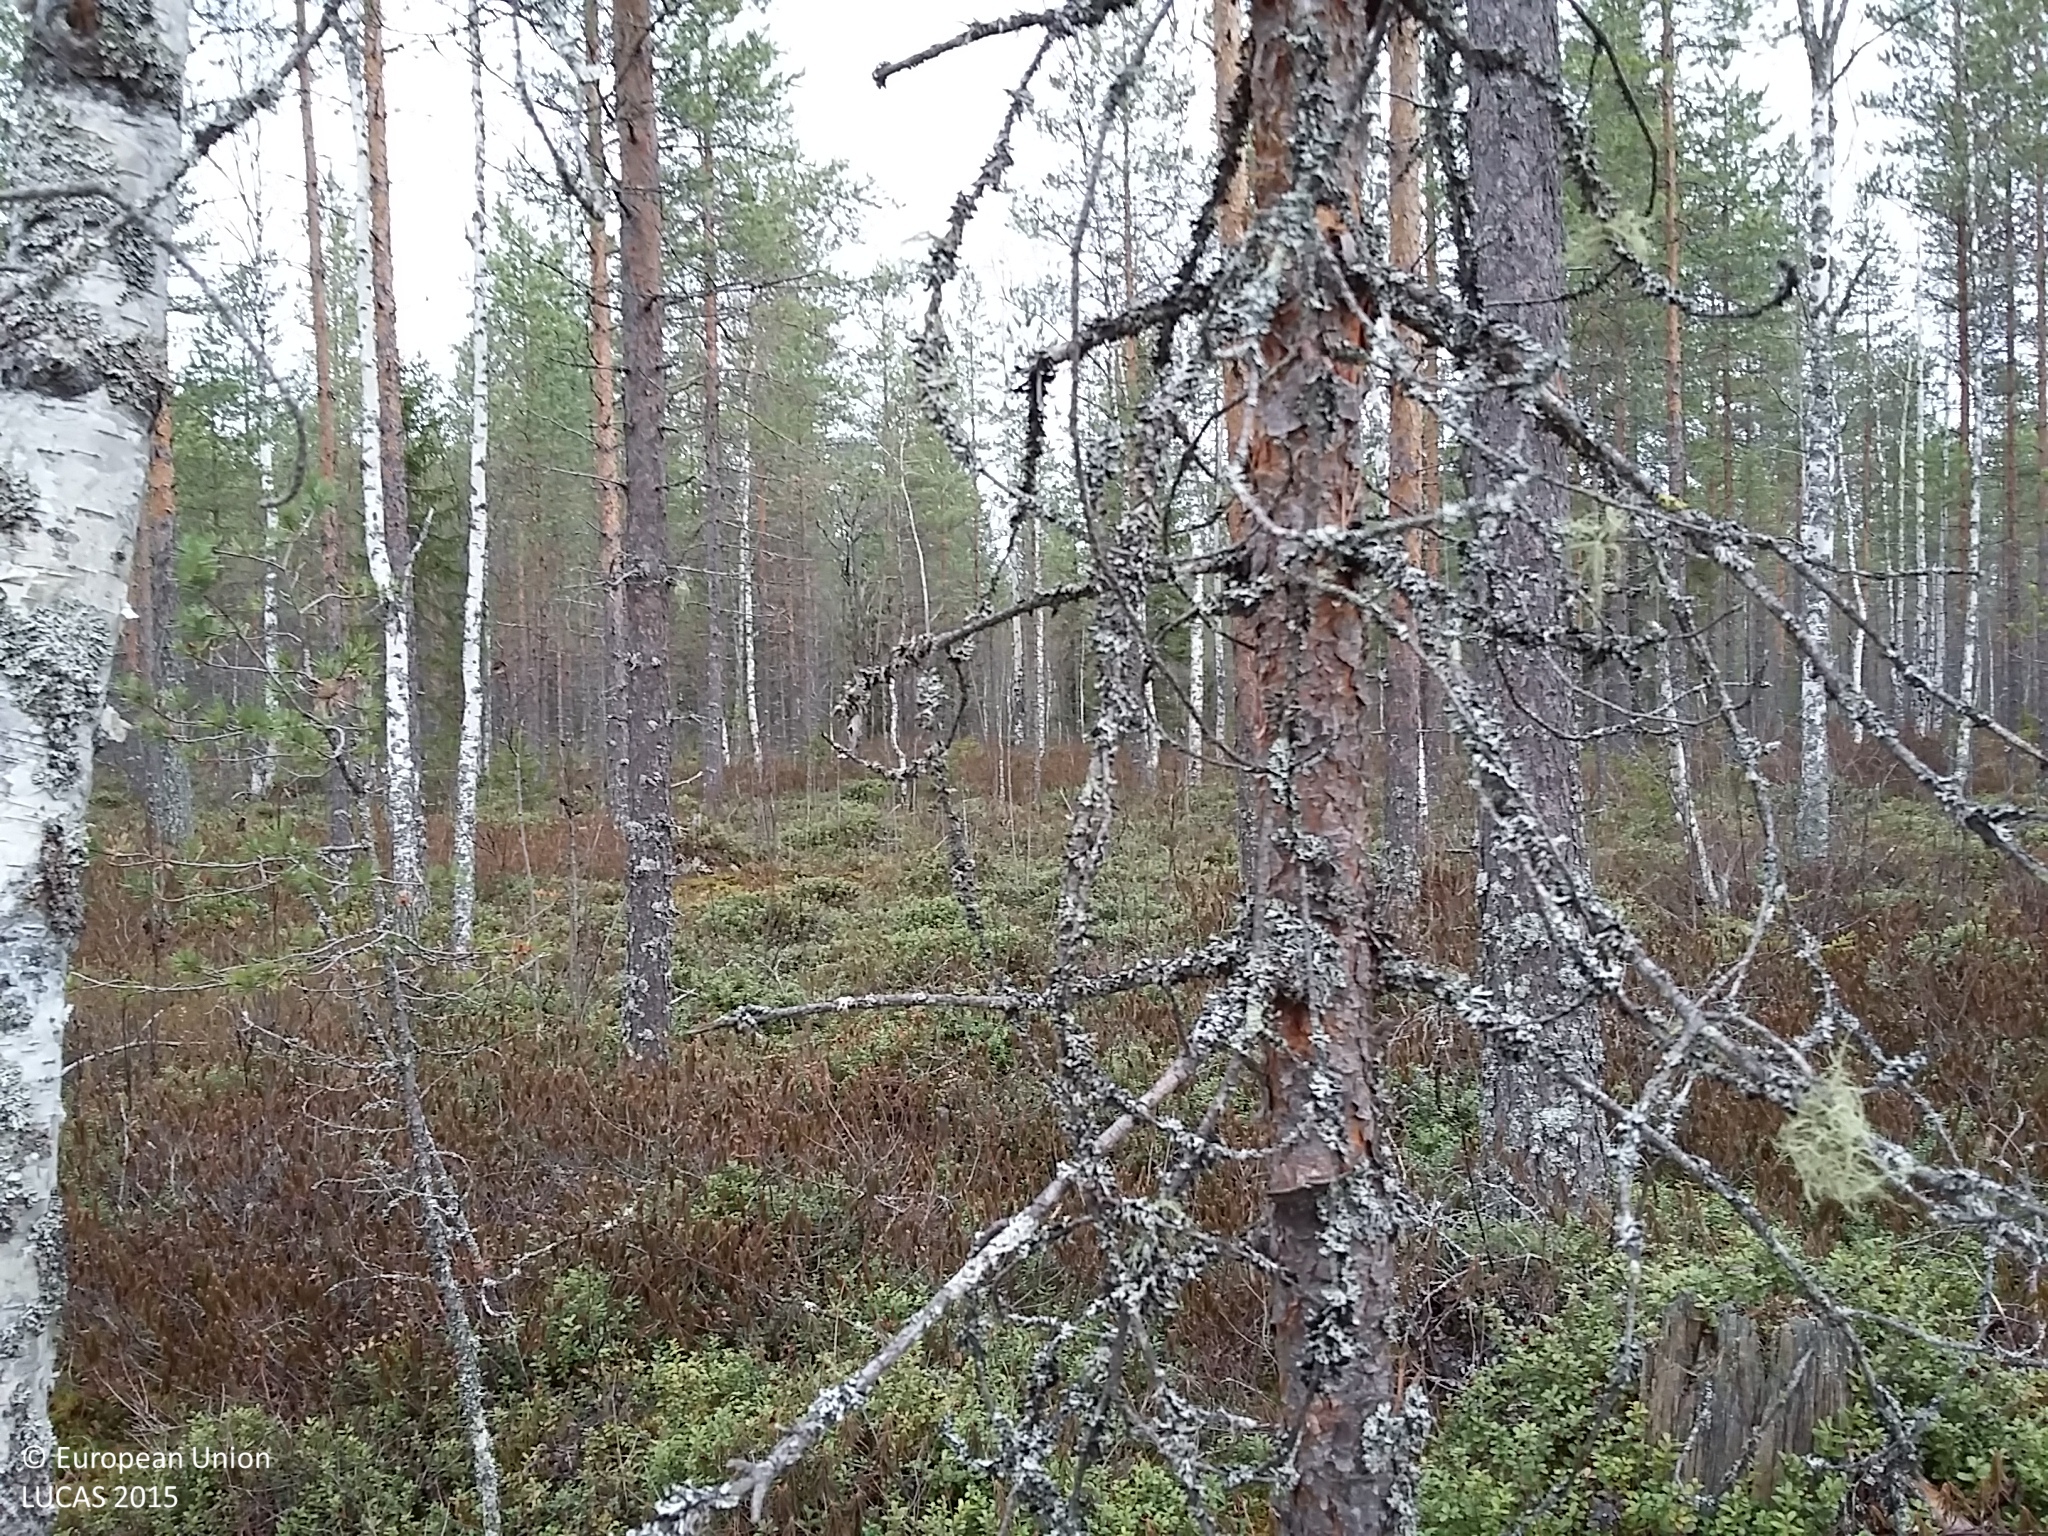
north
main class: Woodland
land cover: Pine dominated mixed woodland
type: boreal forest
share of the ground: > 75 %
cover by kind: coniferous forest trees 55 %, broadleaved forest trees 25 %, shrubs 10 %, lichens and mosses 10 %
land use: Forestry
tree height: > 5 m
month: October
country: FI
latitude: 64.4271
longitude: 25.4758
